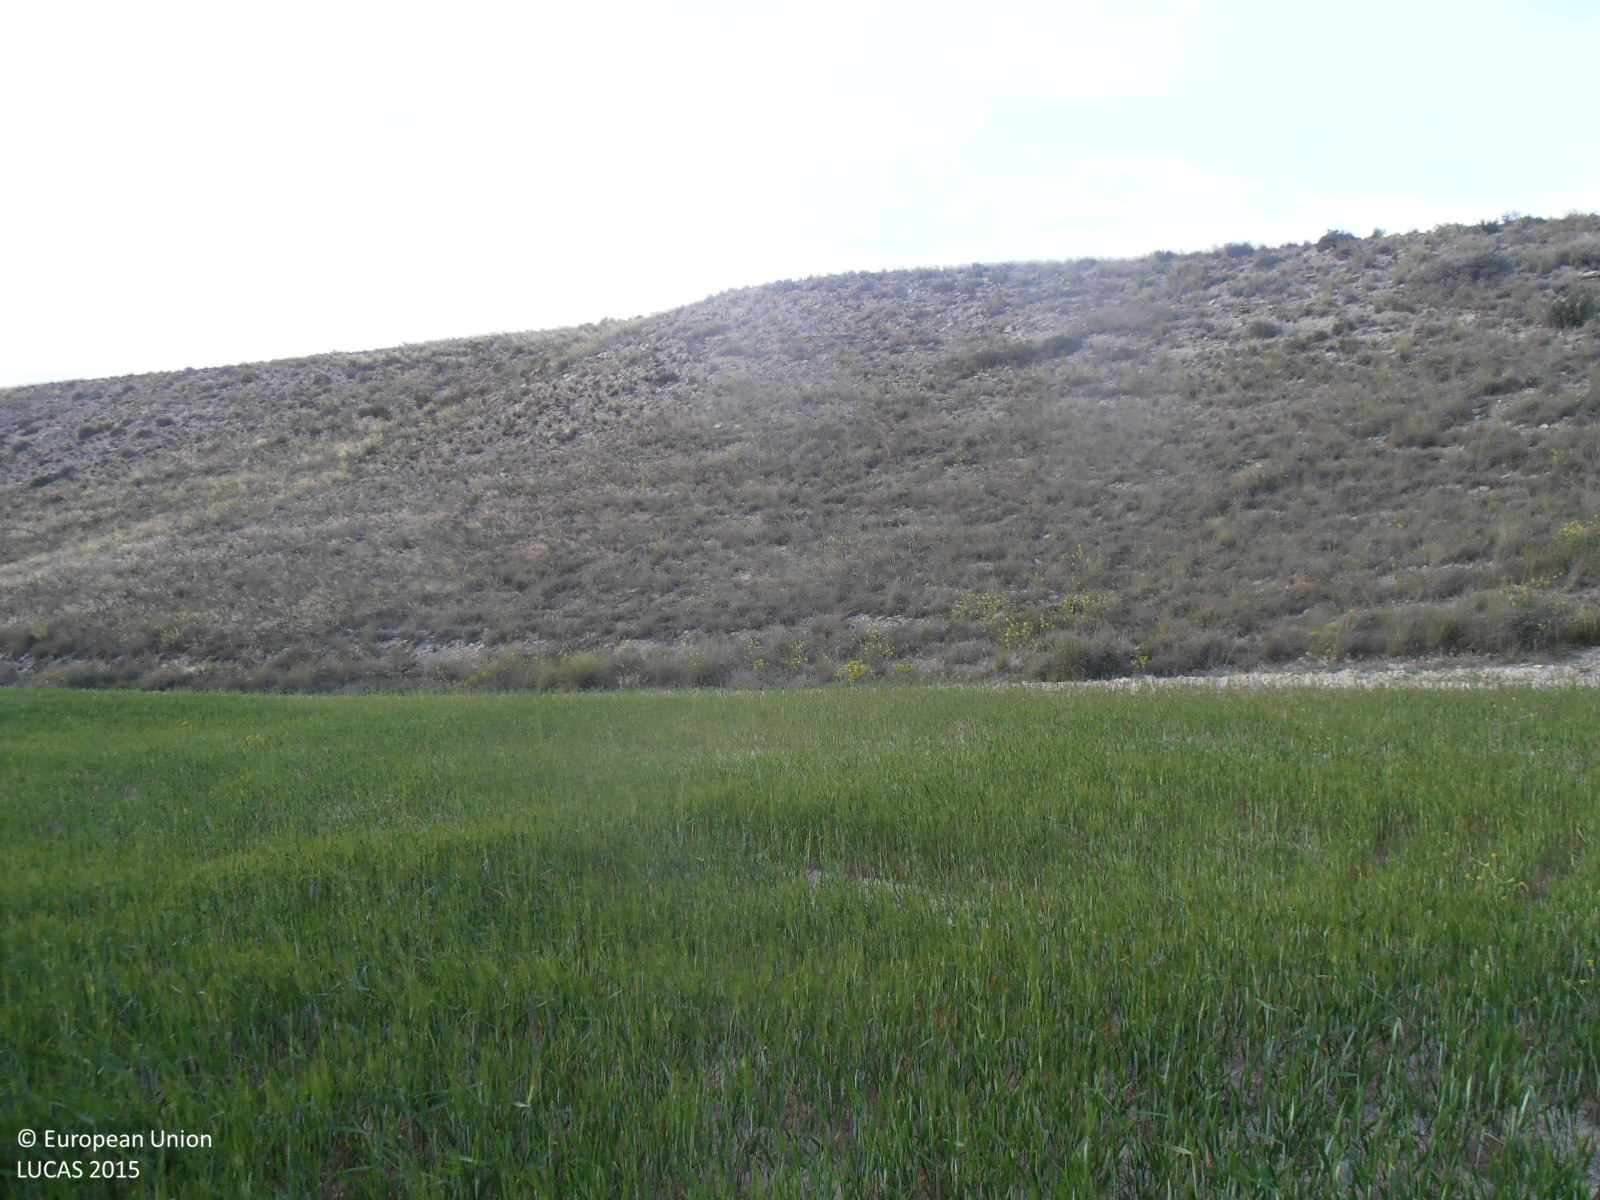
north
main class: Cropland
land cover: Durum wheat
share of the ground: > 75 %
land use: Agriculture (excluding fallow land and kitchen gardens)
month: April
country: ES
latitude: 41.3729
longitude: -0.3817
